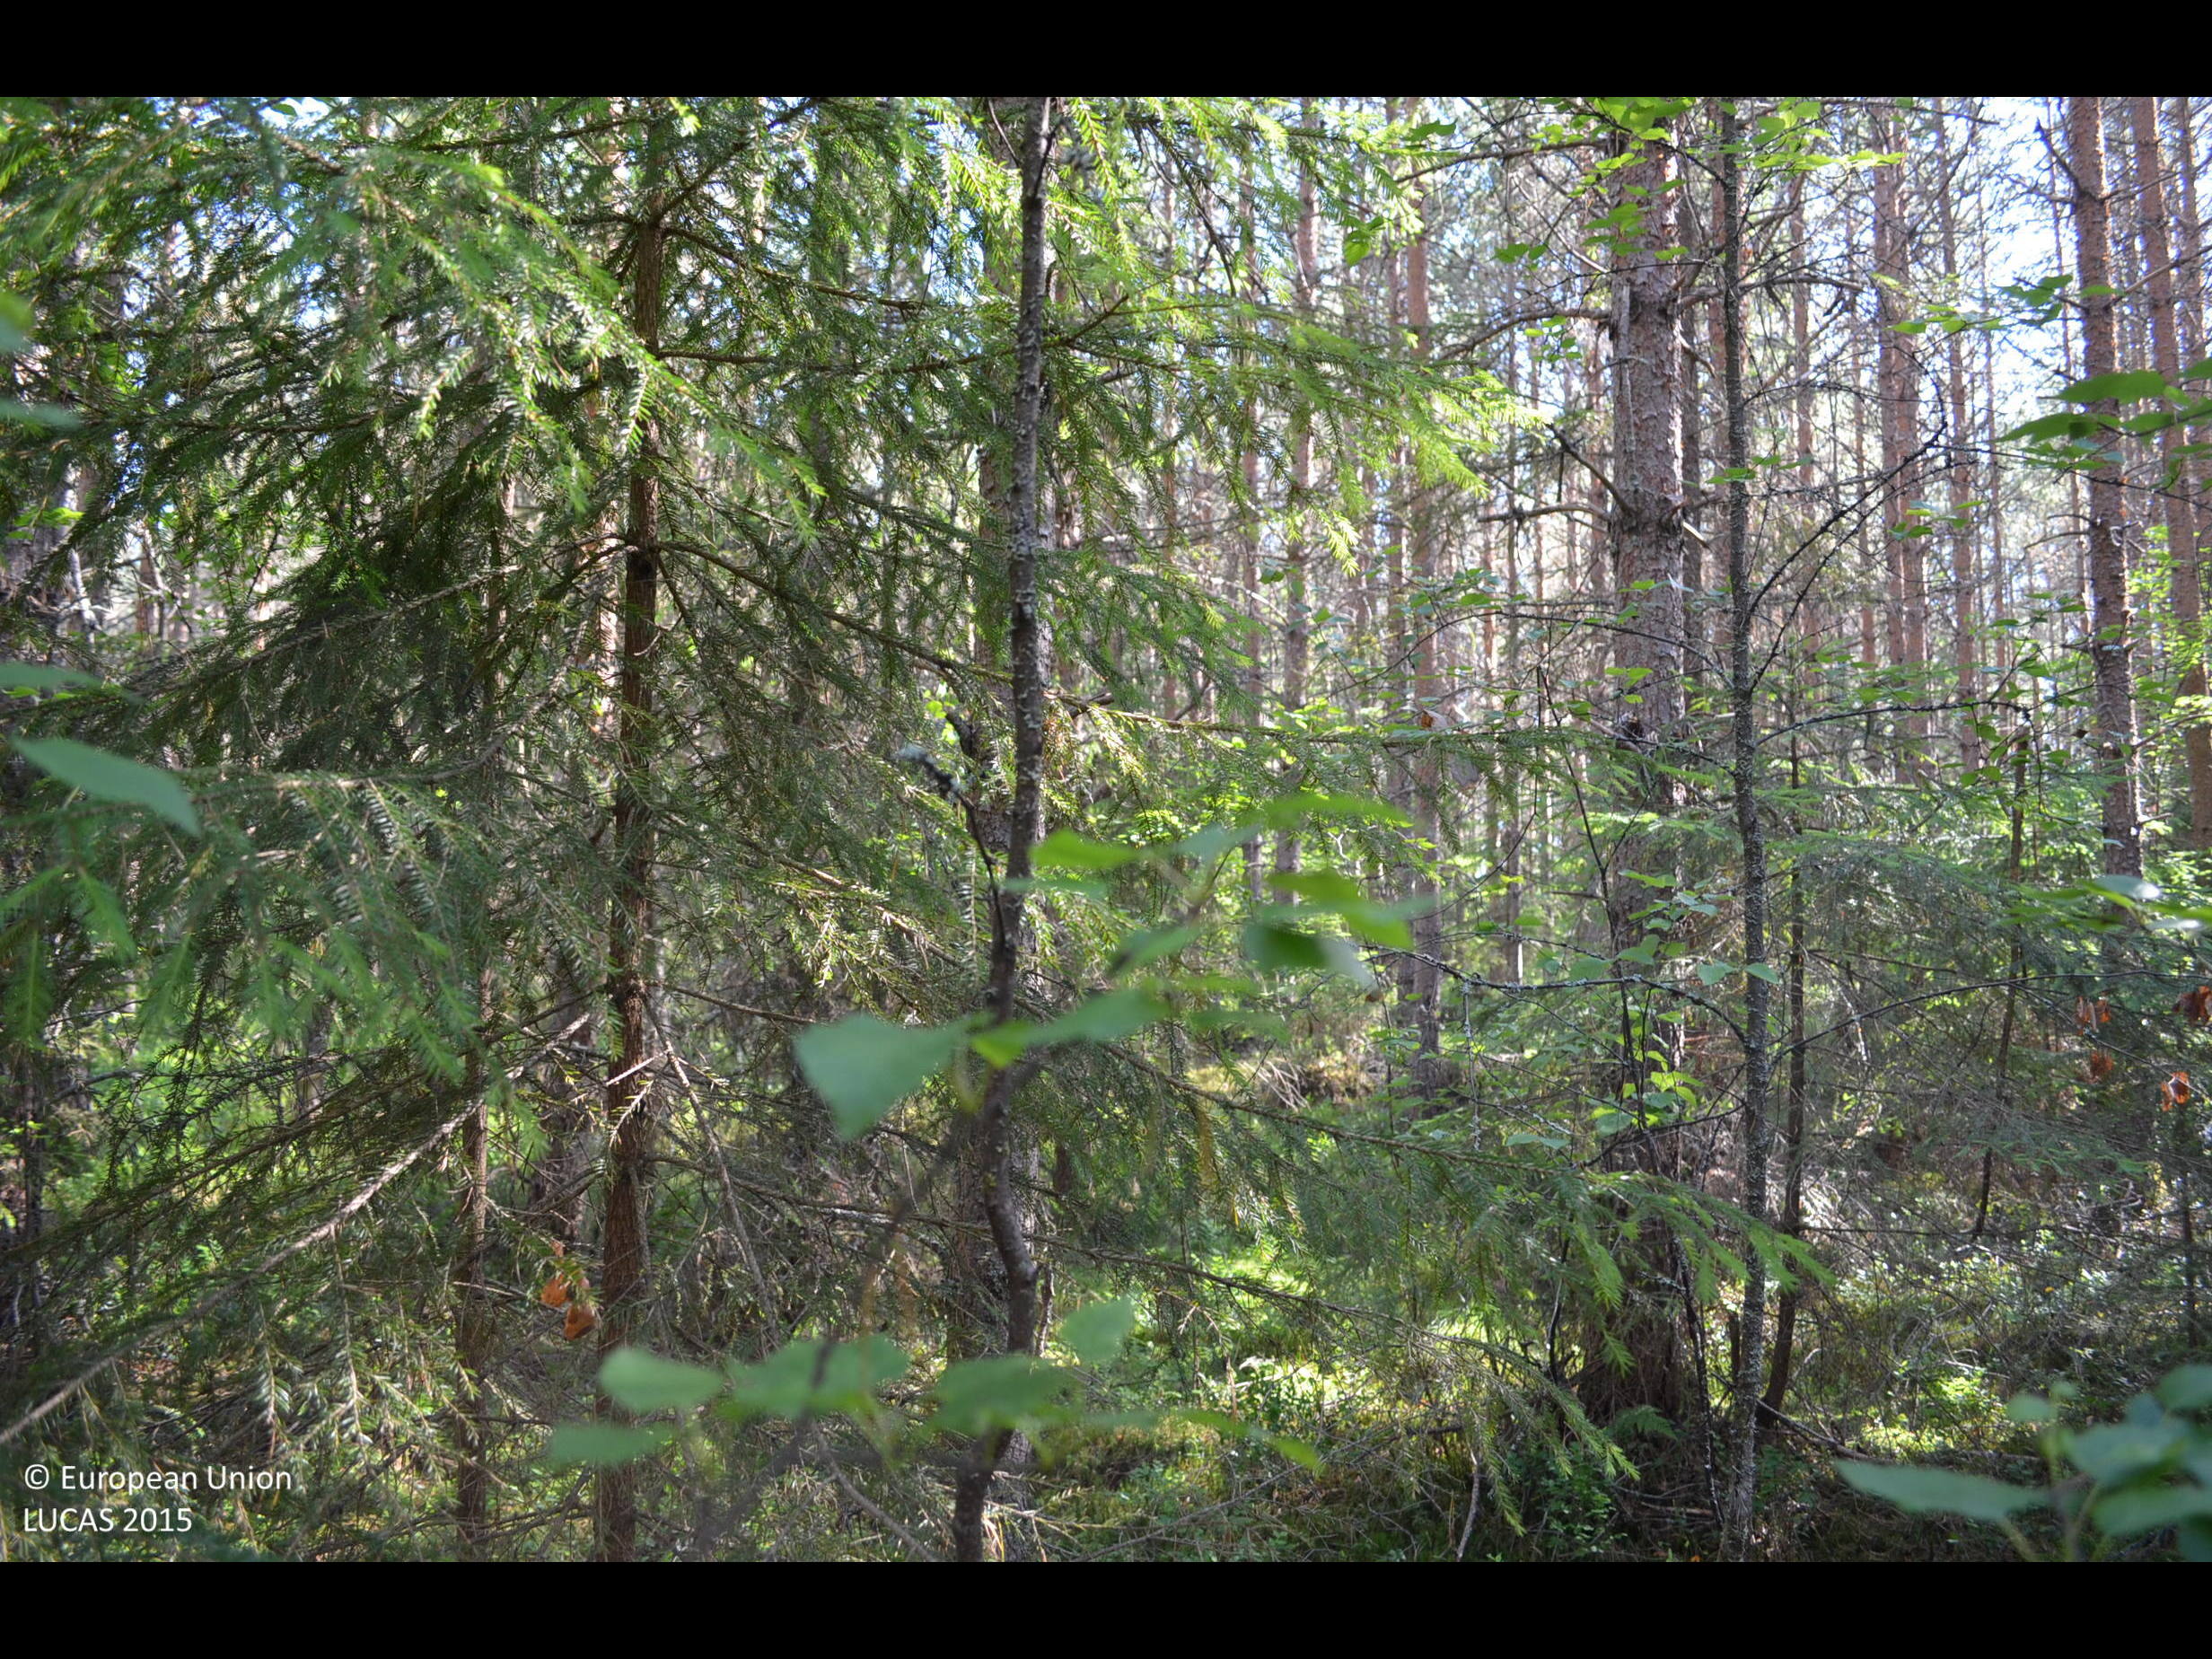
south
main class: Woodland
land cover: Pine dominated coniferous woodland
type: boreal forest
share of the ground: > 75 %
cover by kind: coniferous forest trees 90 %, broadleaved forest trees 5 %, shrubs 5 %
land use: Forestry
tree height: > 5 m
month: July
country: FI
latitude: 61.8035
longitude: 23.4512
